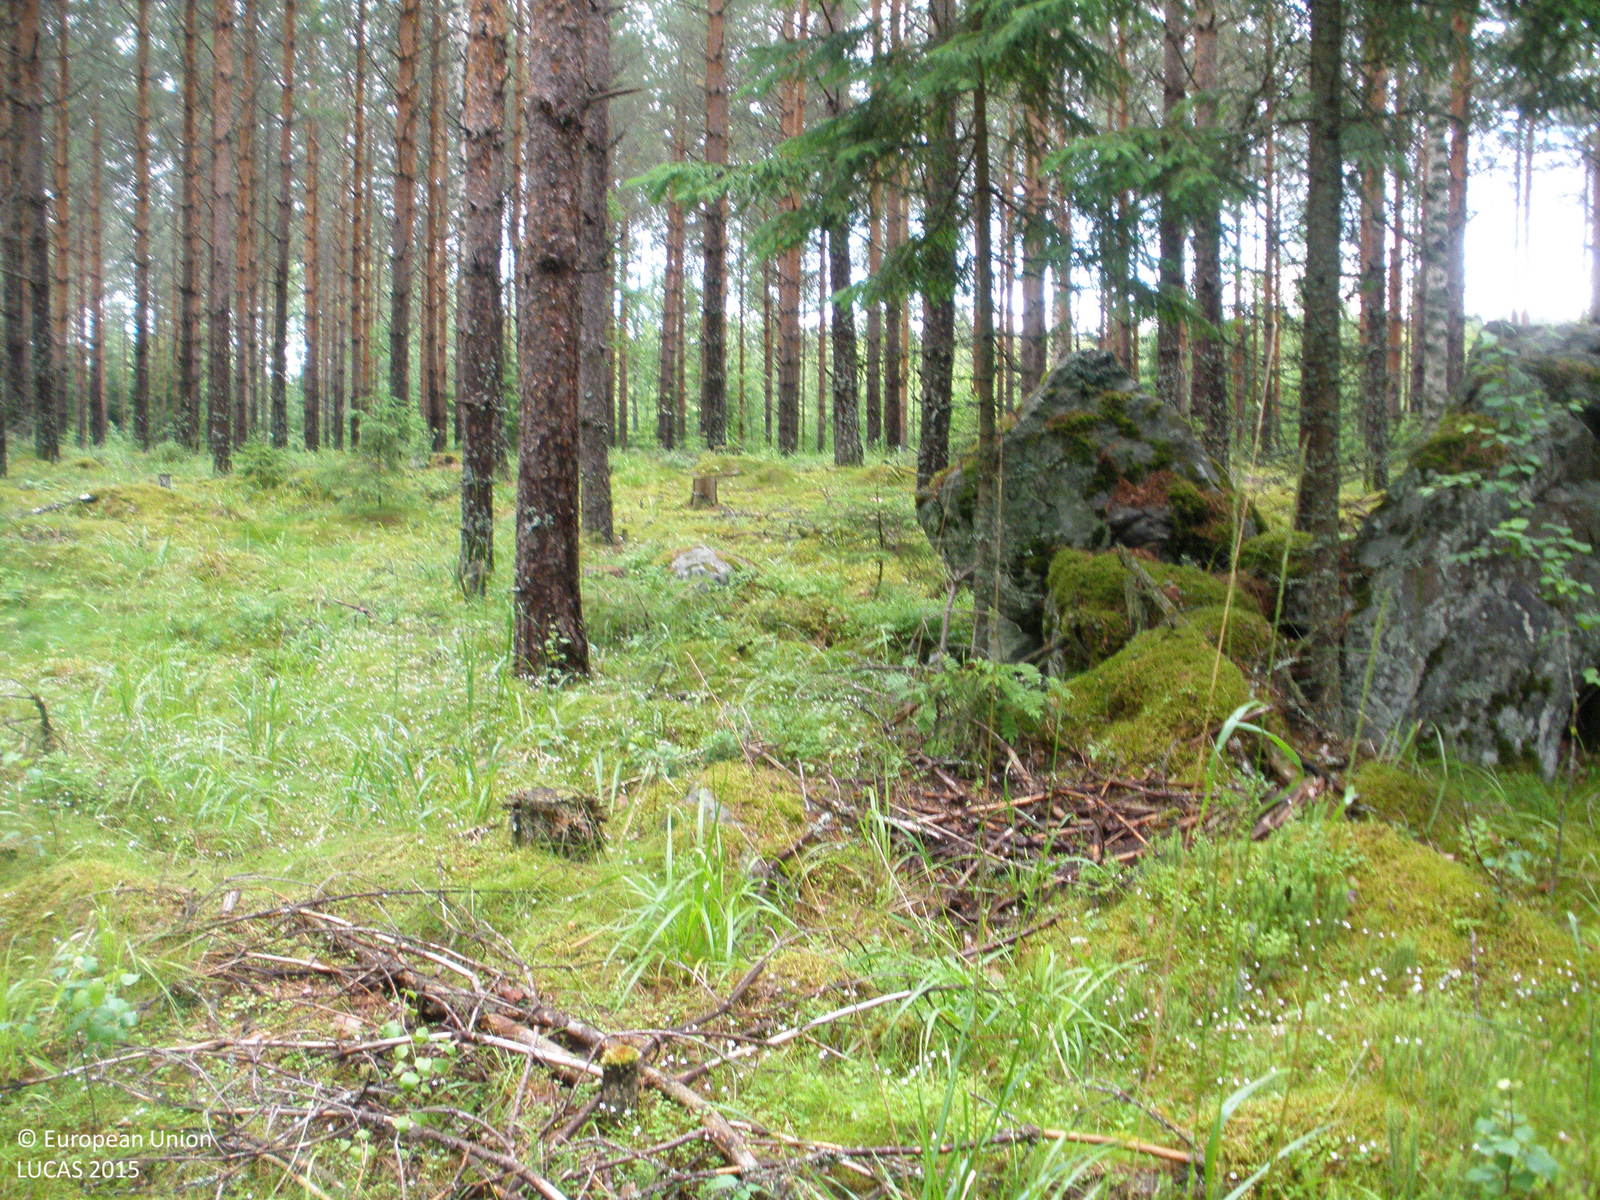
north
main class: Woodland
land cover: Pine dominated coniferous woodland
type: boreal forest
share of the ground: > 75 %
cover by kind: coniferous forest trees 80 %, lichens and mosses 10 %, broadleaved forest trees 5 %, herbaceous plants 5 %
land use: Forestry
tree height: > 5 m
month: July
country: FI
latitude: 61.3870
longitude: 23.1971
